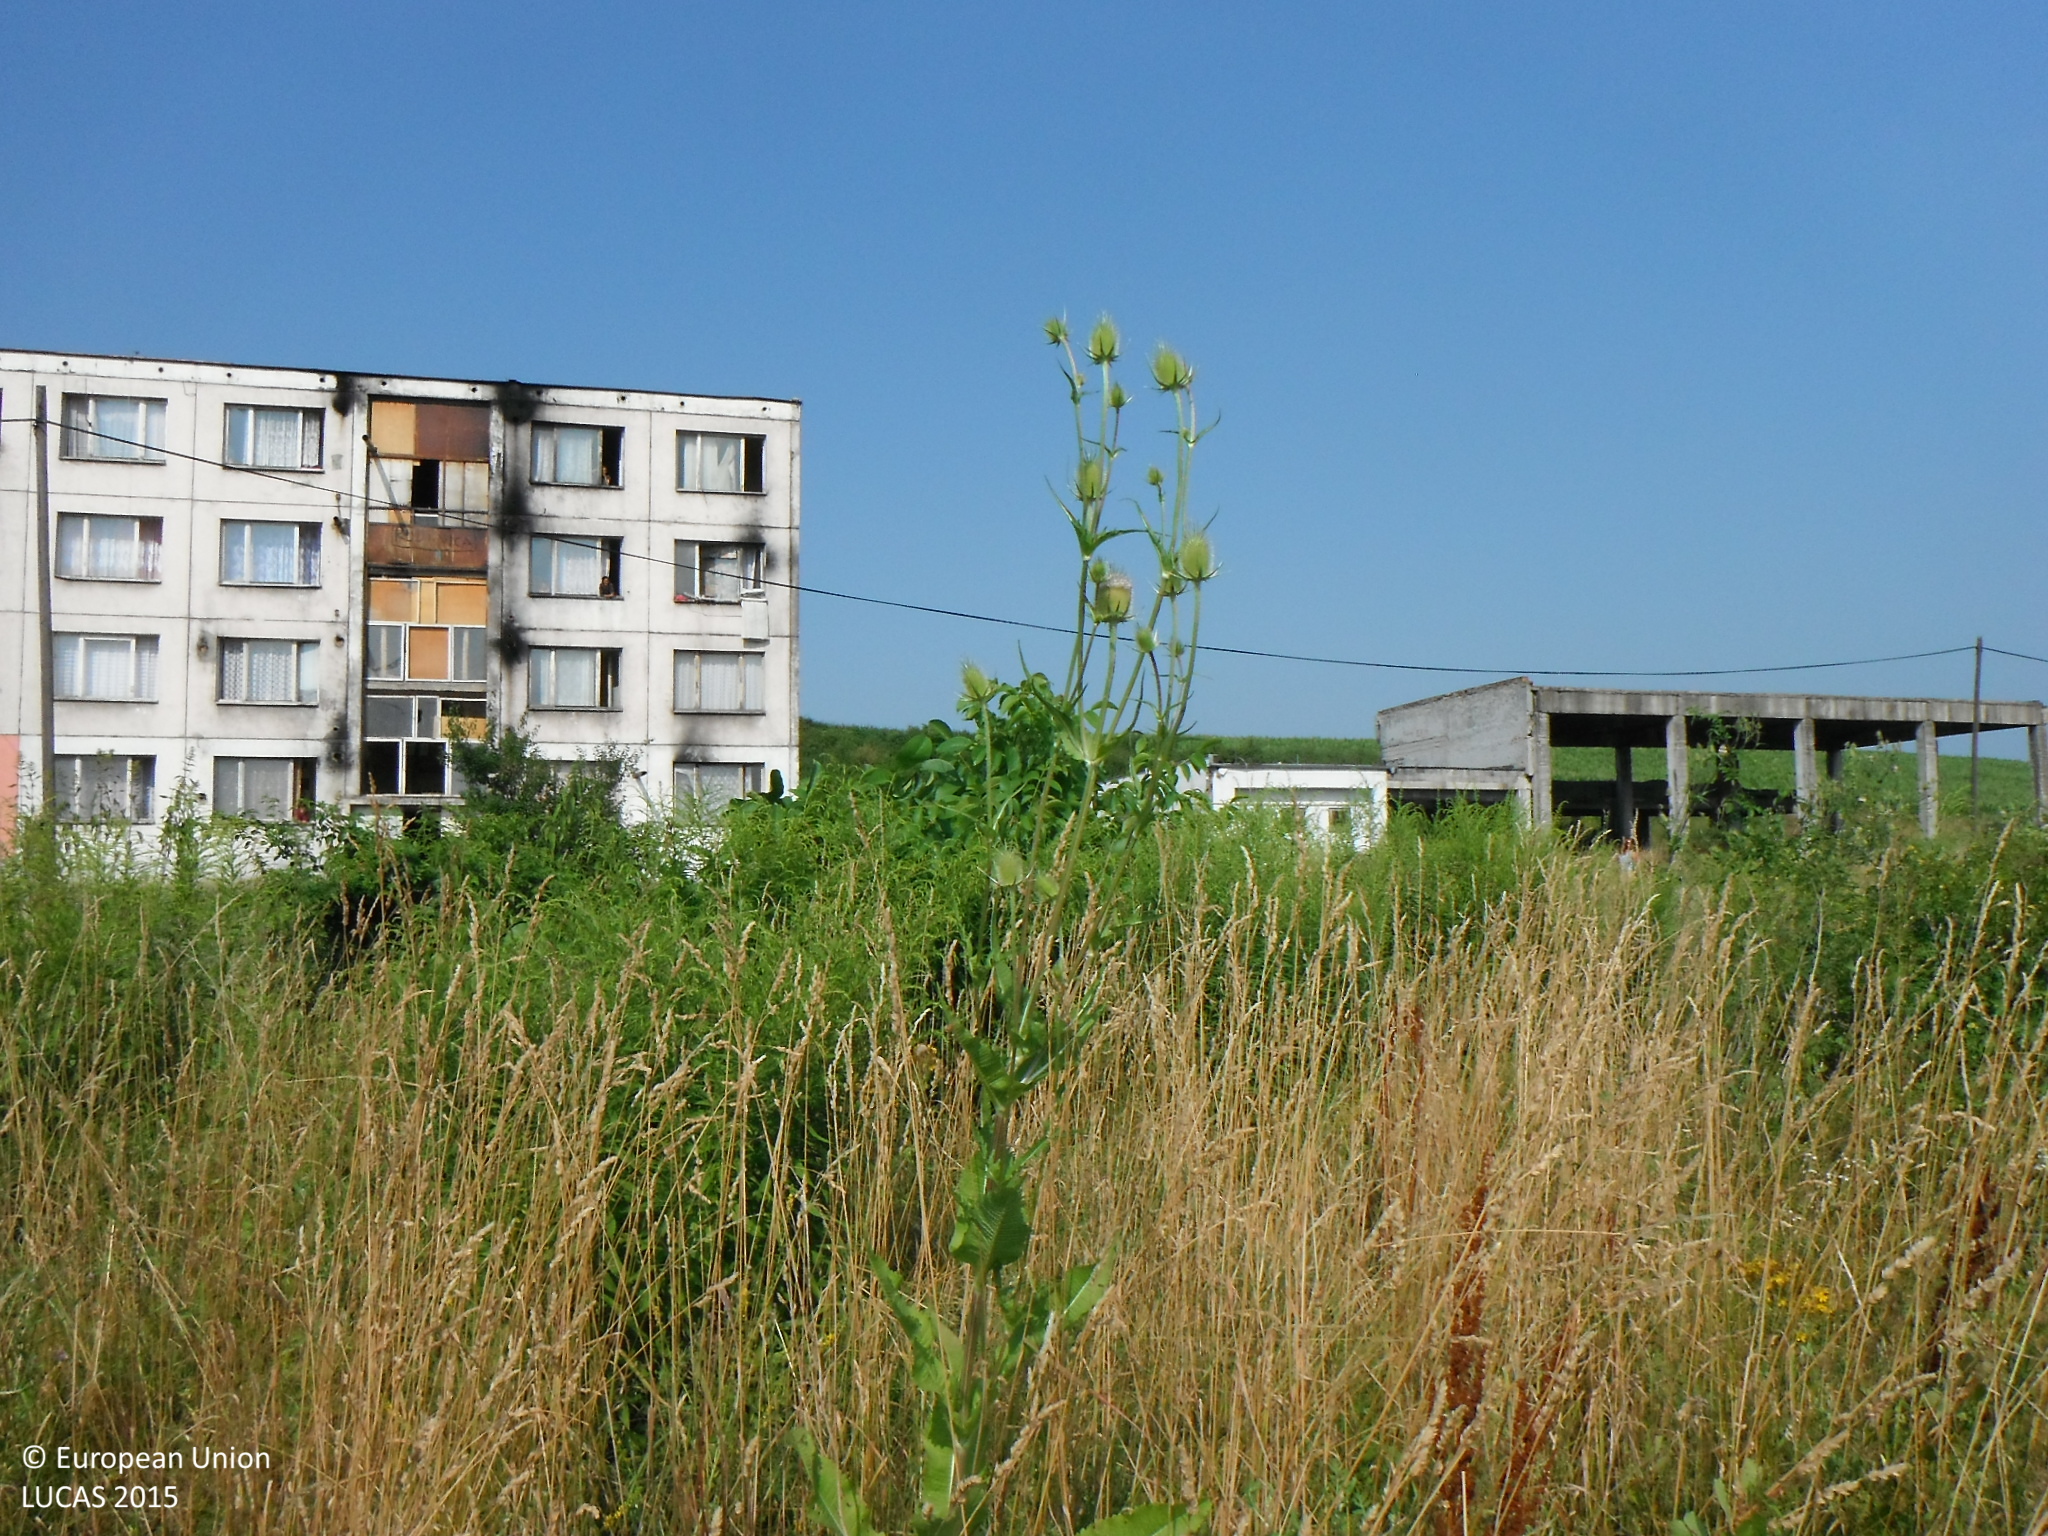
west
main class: Grassland
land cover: Spontaneously vegetated surfaces
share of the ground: > 75 %
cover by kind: herbaceous plants 100 %
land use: Semi-natural and natural areas not in use
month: July
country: SK
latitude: 48.3656
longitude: 20.0043
